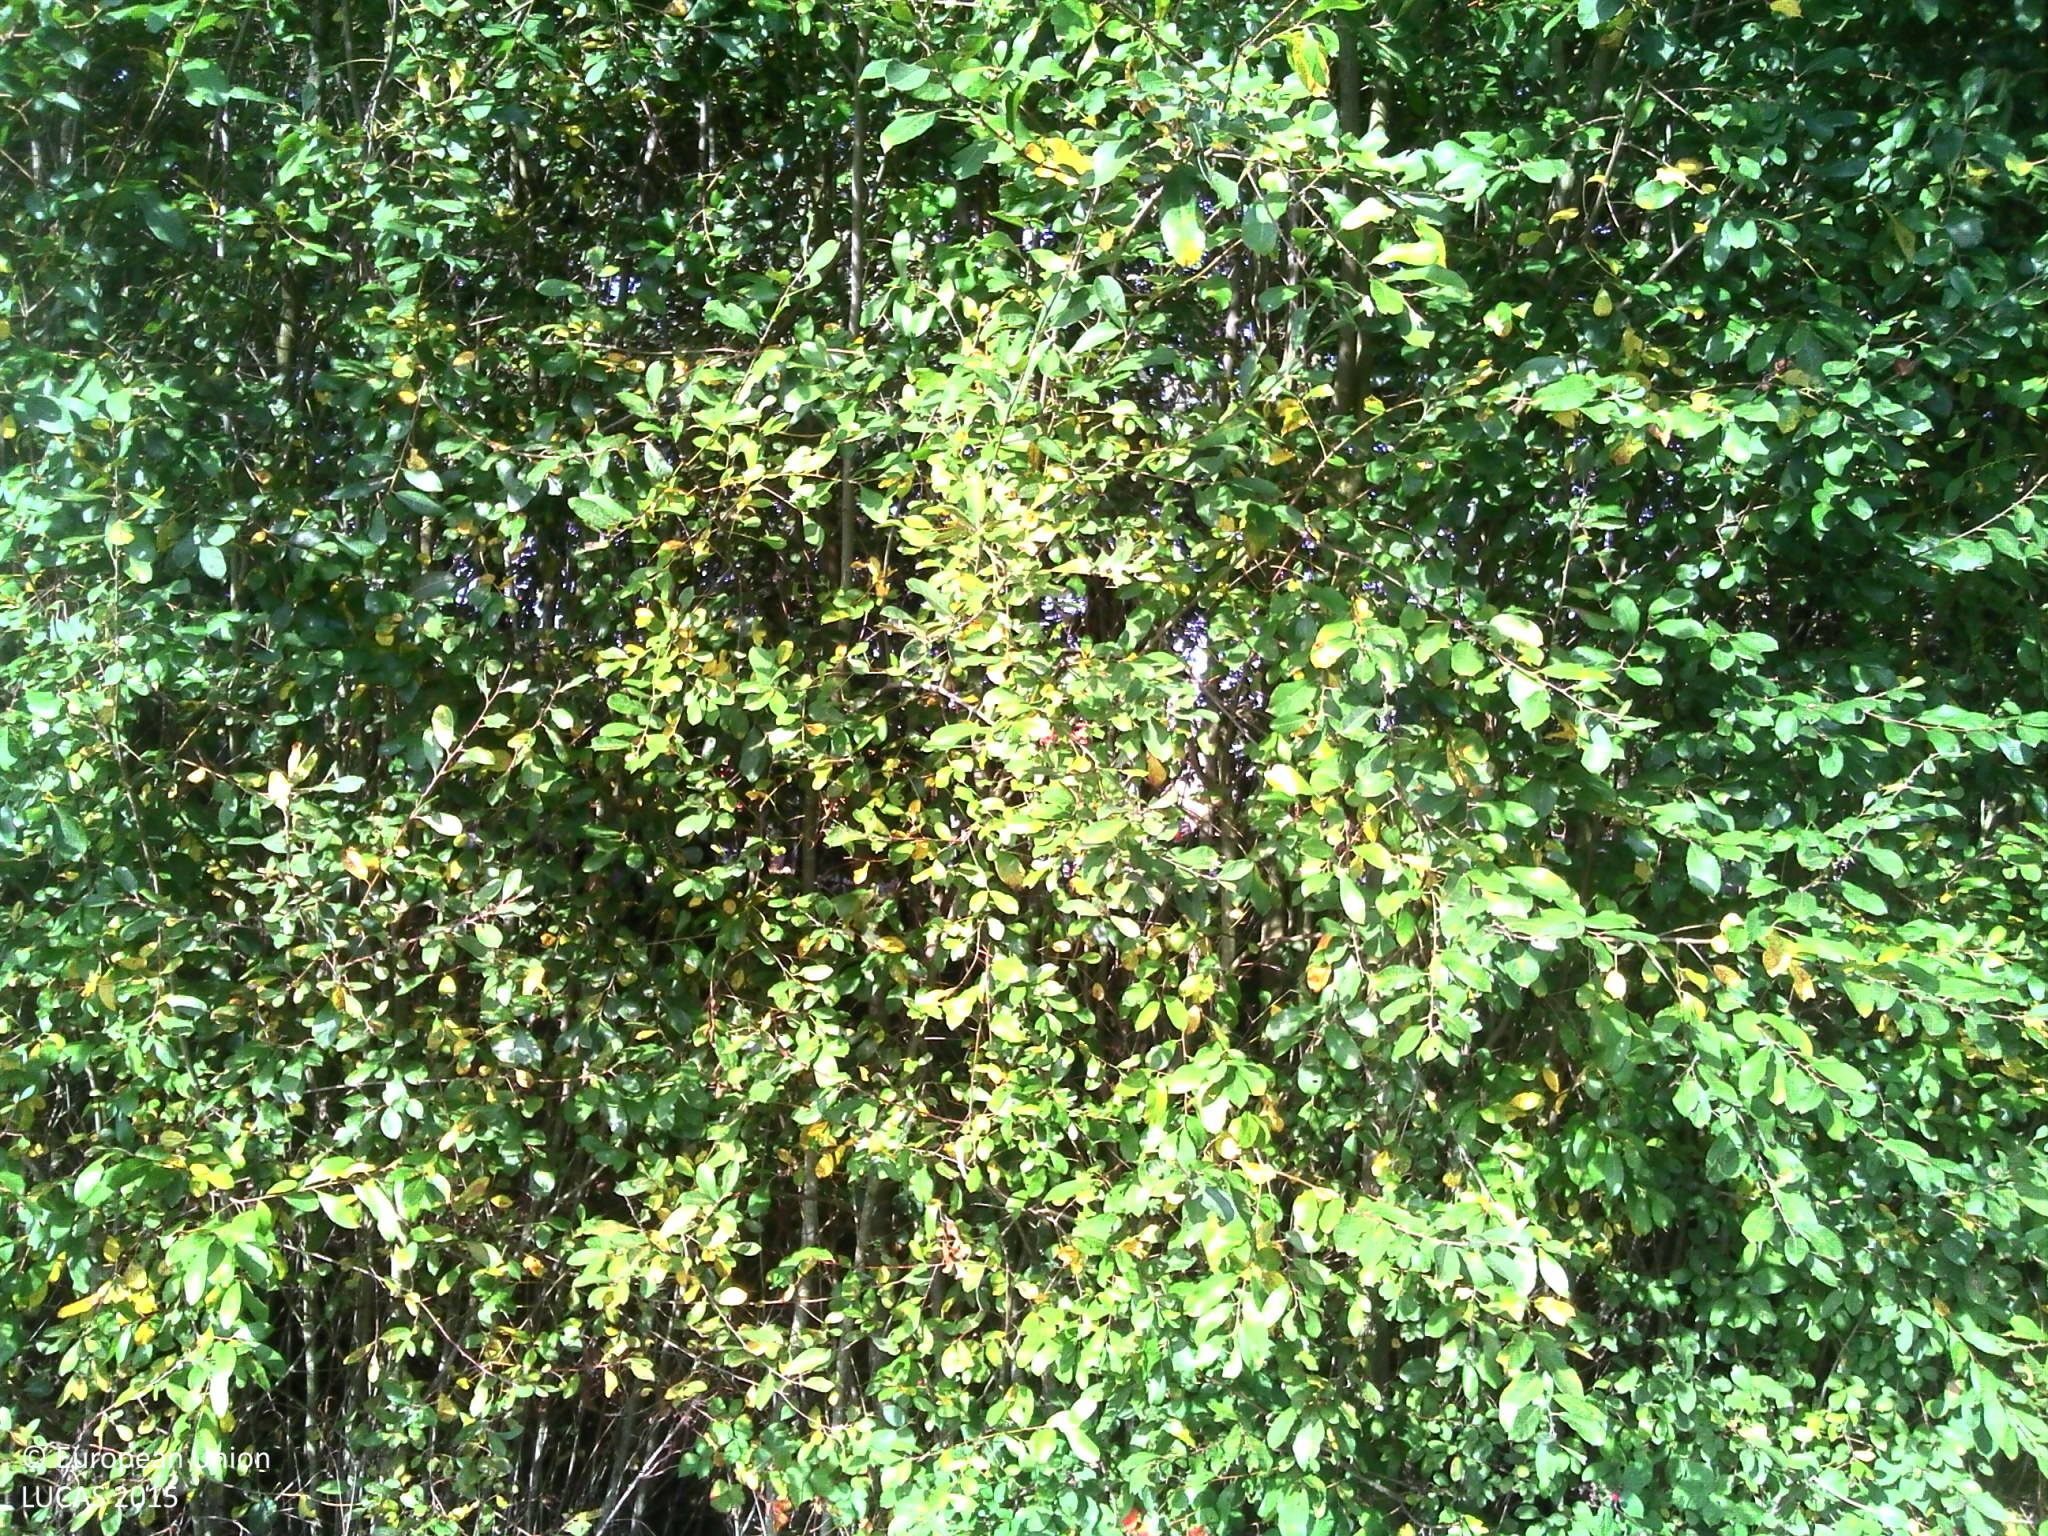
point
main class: Woodland
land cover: Broadleaved woodland
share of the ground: > 75 %
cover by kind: broadleaved forest trees 95 %, shrubs 5 %
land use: Semi-natural and natural areas not in use
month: October
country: FR
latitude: 47.2191
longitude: -0.9822
